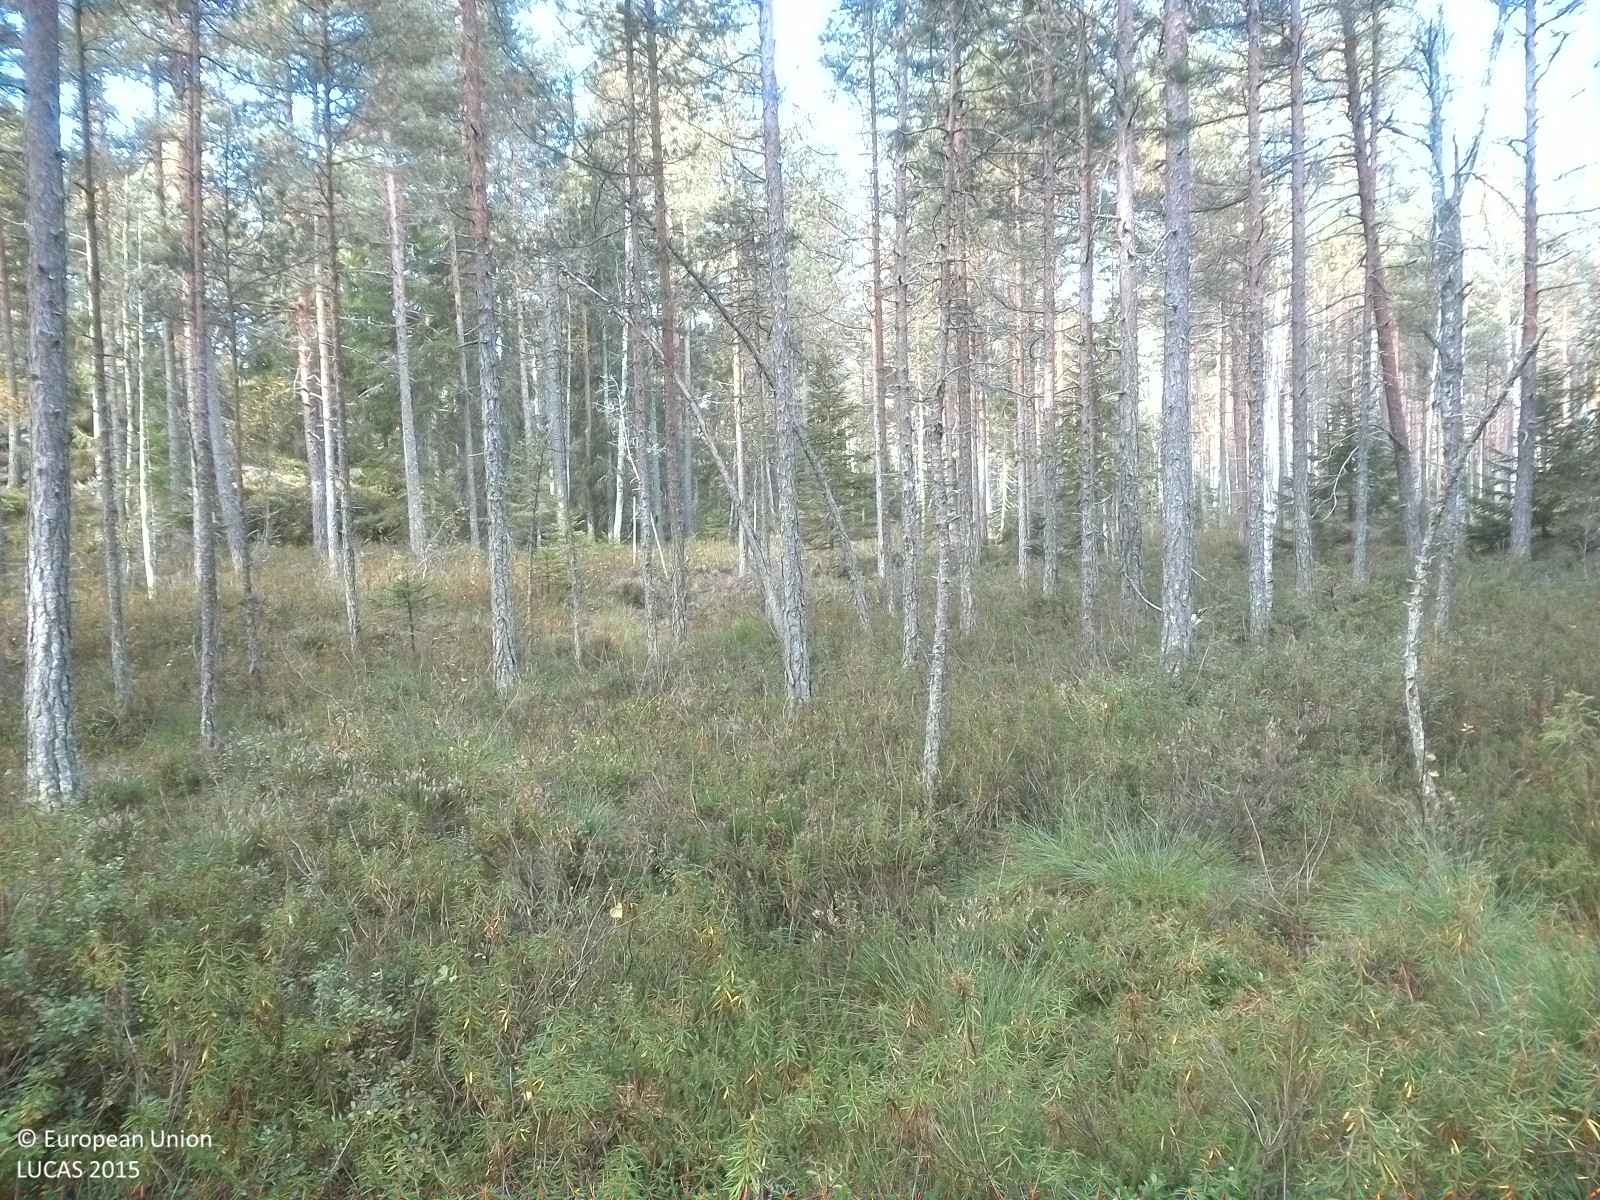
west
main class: Woodland
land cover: Pine dominated coniferous woodland
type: boreal forest
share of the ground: 10 - 25 %
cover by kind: shrubs 50 %, coniferous forest trees 20 %, lichens and mosses 20 %, herbaceous plants 10 %
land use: Forestry
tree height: > 5 m
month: September
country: SE
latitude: 58.9611
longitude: 15.7833
